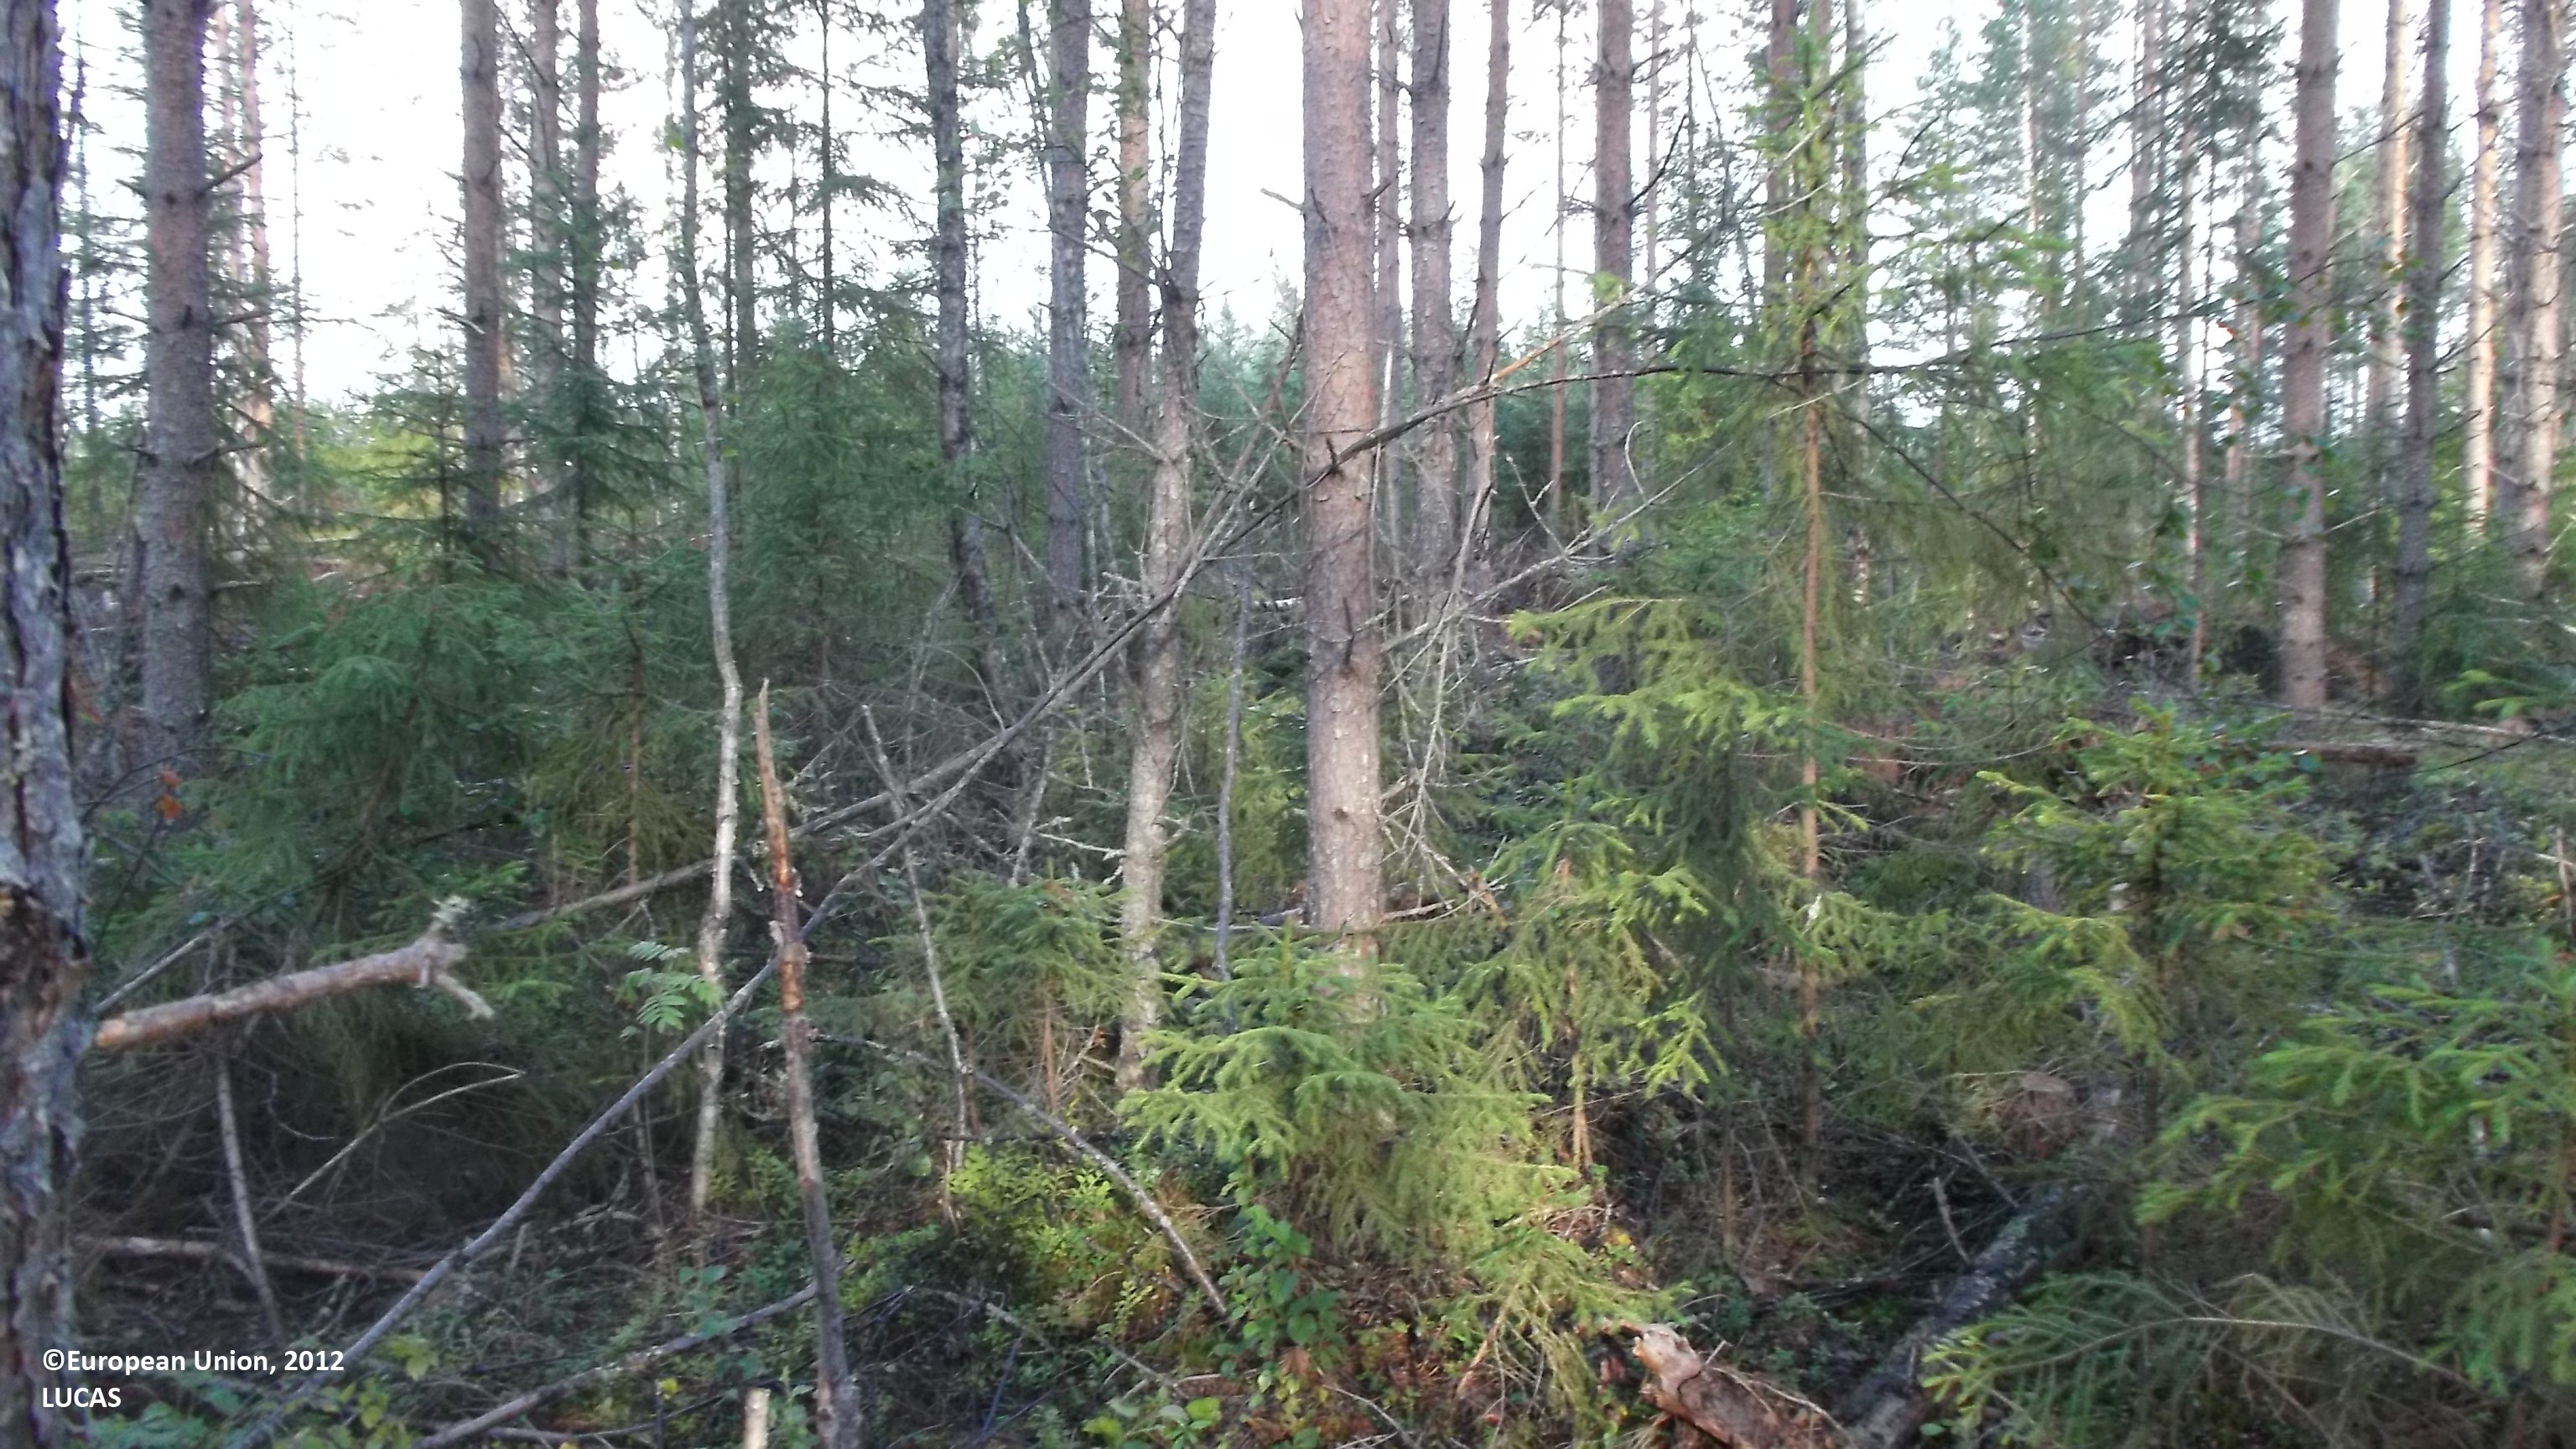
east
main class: Woodland
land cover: Pine dominated mixed woodland
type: boreal forest
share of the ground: 25 - 50 %
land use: Forestry
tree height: > 5 m
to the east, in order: Pine dominated mixed woodland; Tracks; Pine dominated mixed woodland; Other mixed woodland; Spontaneously vegetated surfaces; Pine dominated mixed woodland
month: August
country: FI
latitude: 63.9246
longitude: 23.3296
